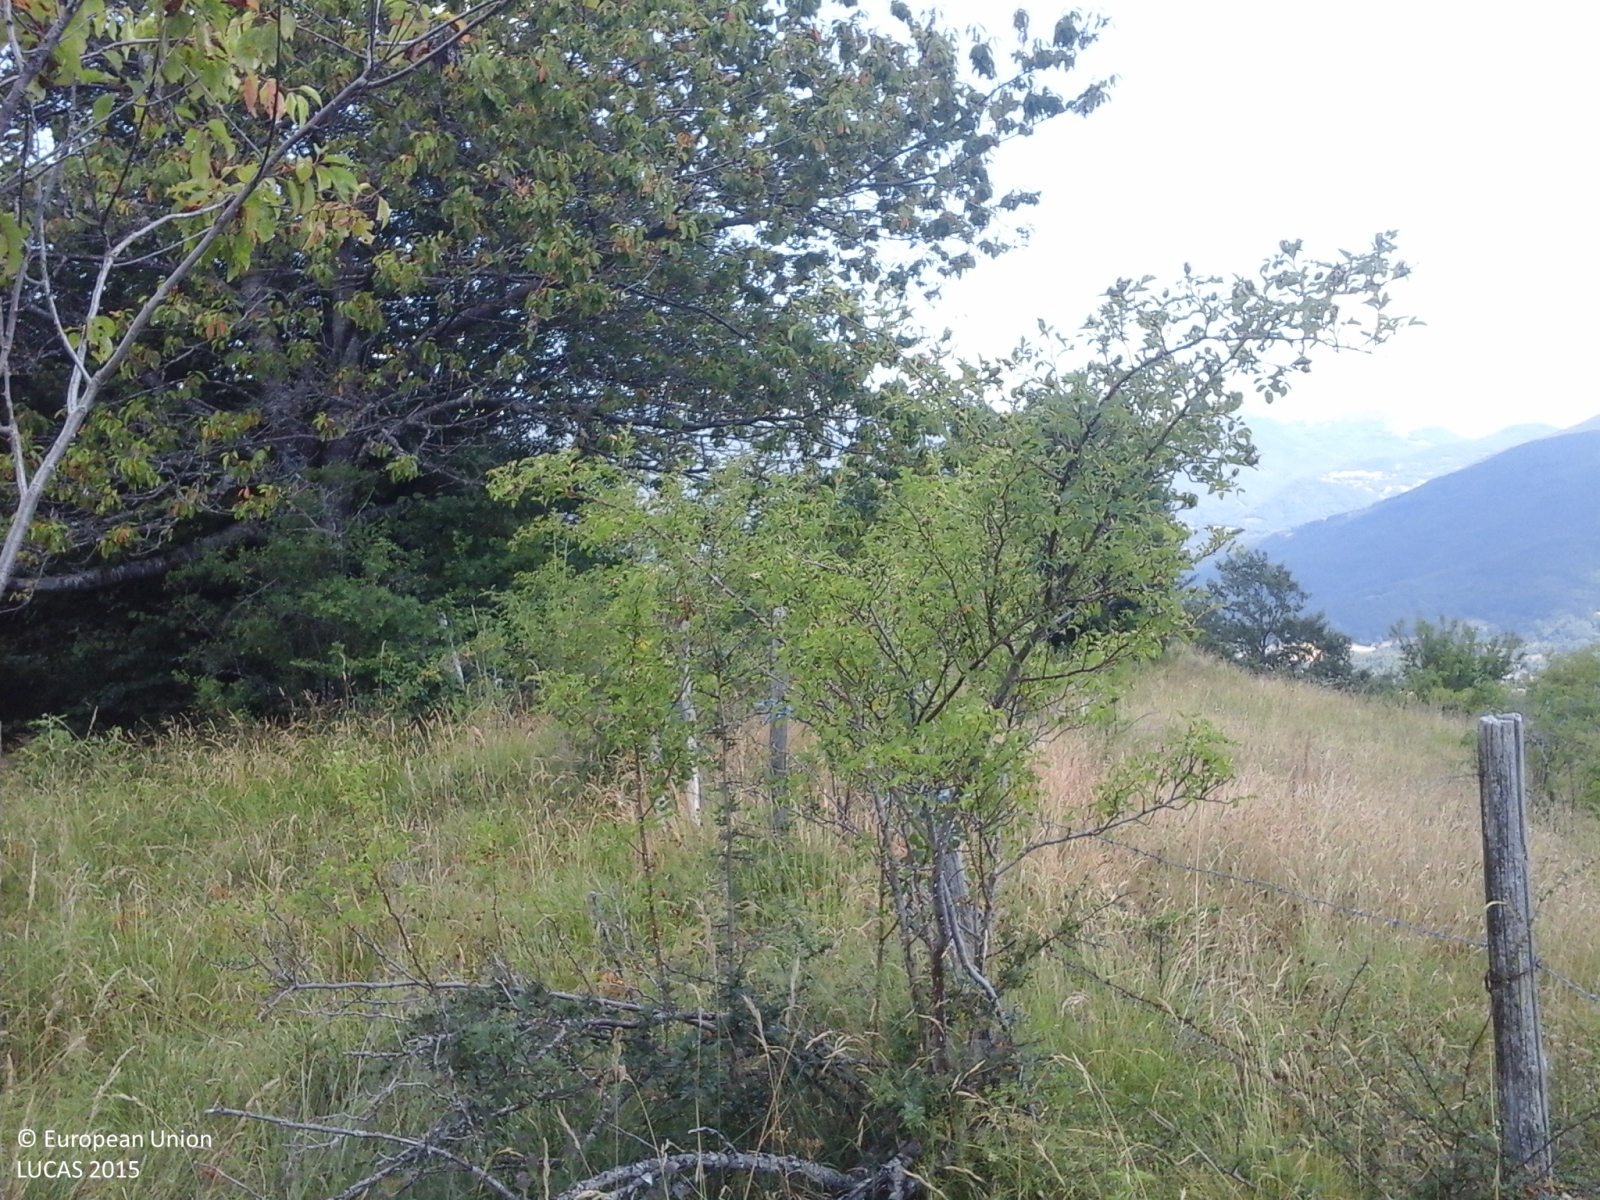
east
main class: Grassland
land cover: Grassland with sparse tree/shrub cover
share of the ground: > 75 %
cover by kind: herbaceous plants 90 %, broadleaved forest trees 5 %, shrubs 5 %
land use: Agriculture (excluding fallow land and kitchen gardens)
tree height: > 5 m
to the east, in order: Grassland with sparse tree/shrub cover; Broadleaved woodland; Artificial constructions in urban areas; Other bare soil; Grassland without tree/shrub cover; Electric lines; Grassland without tree/shrub cover
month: July
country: IT
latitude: 44.2046
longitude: 10.5868
